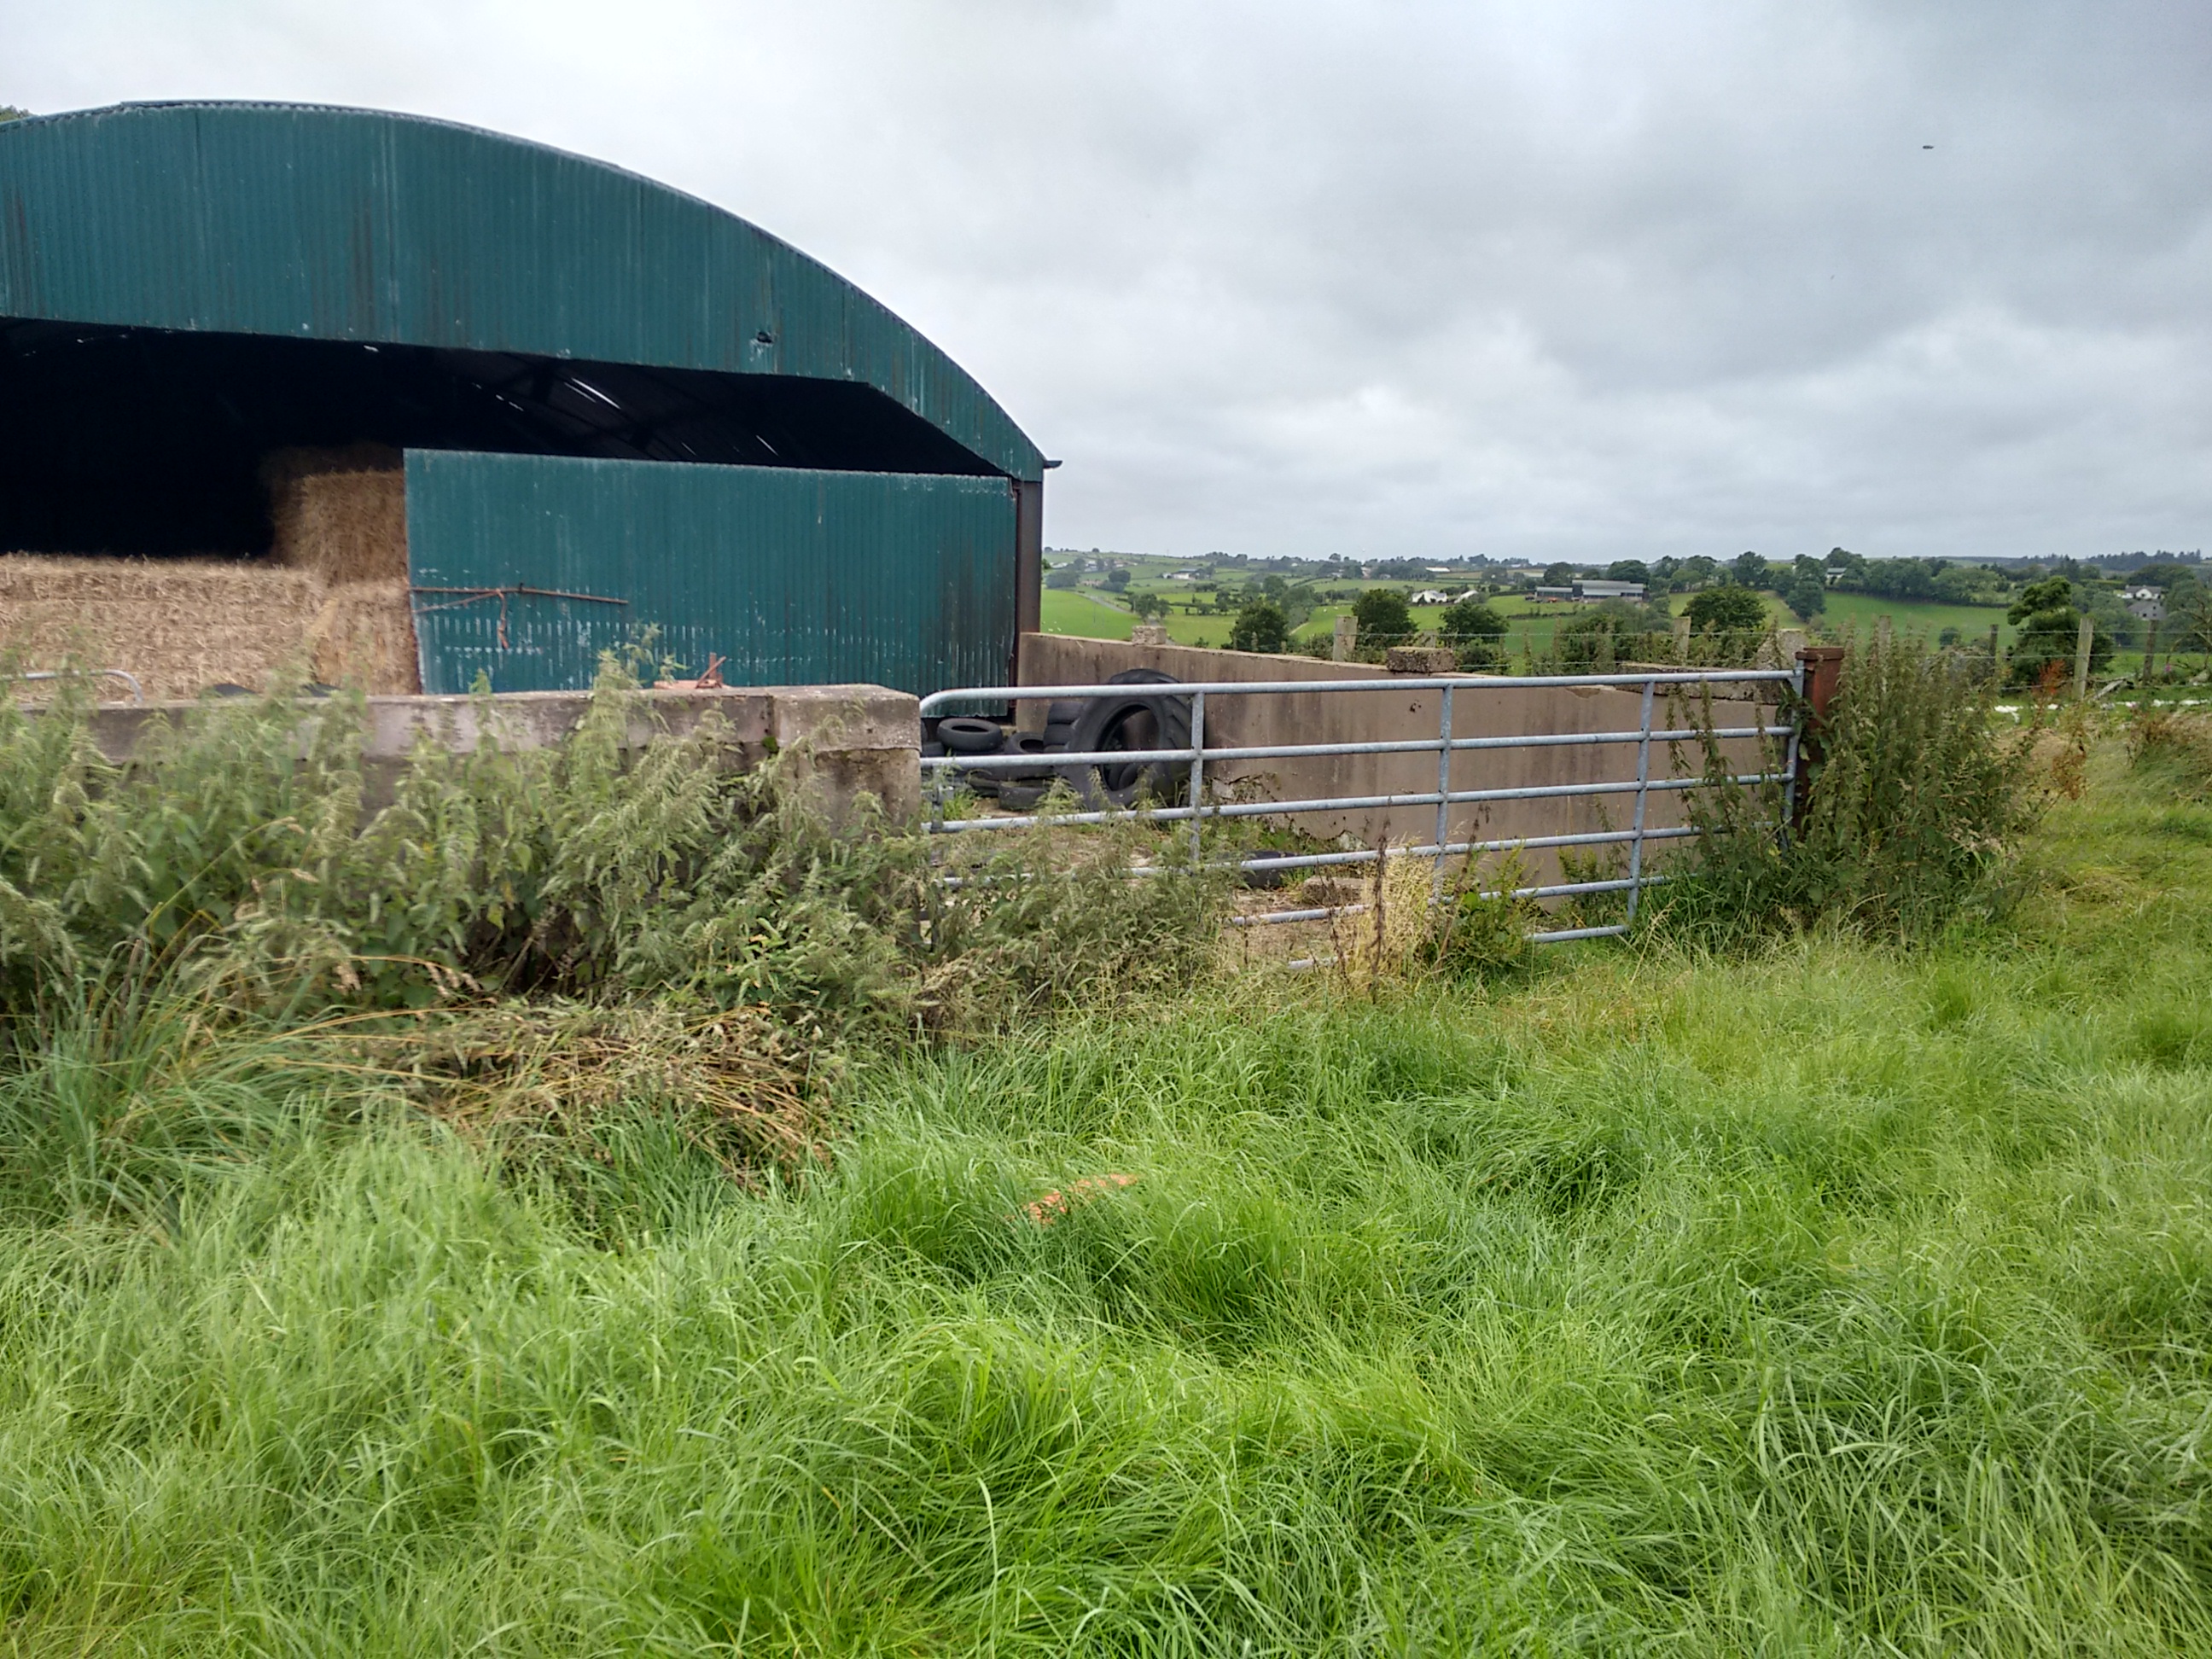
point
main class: Grassland
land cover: Grassland without tree/shrub cover
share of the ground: > 75 %
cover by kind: herbaceous plants 100 %
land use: Agriculture (excluding fallow land and kitchen gardens)
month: August
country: GB
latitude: 54.6115
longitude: -6.9050
